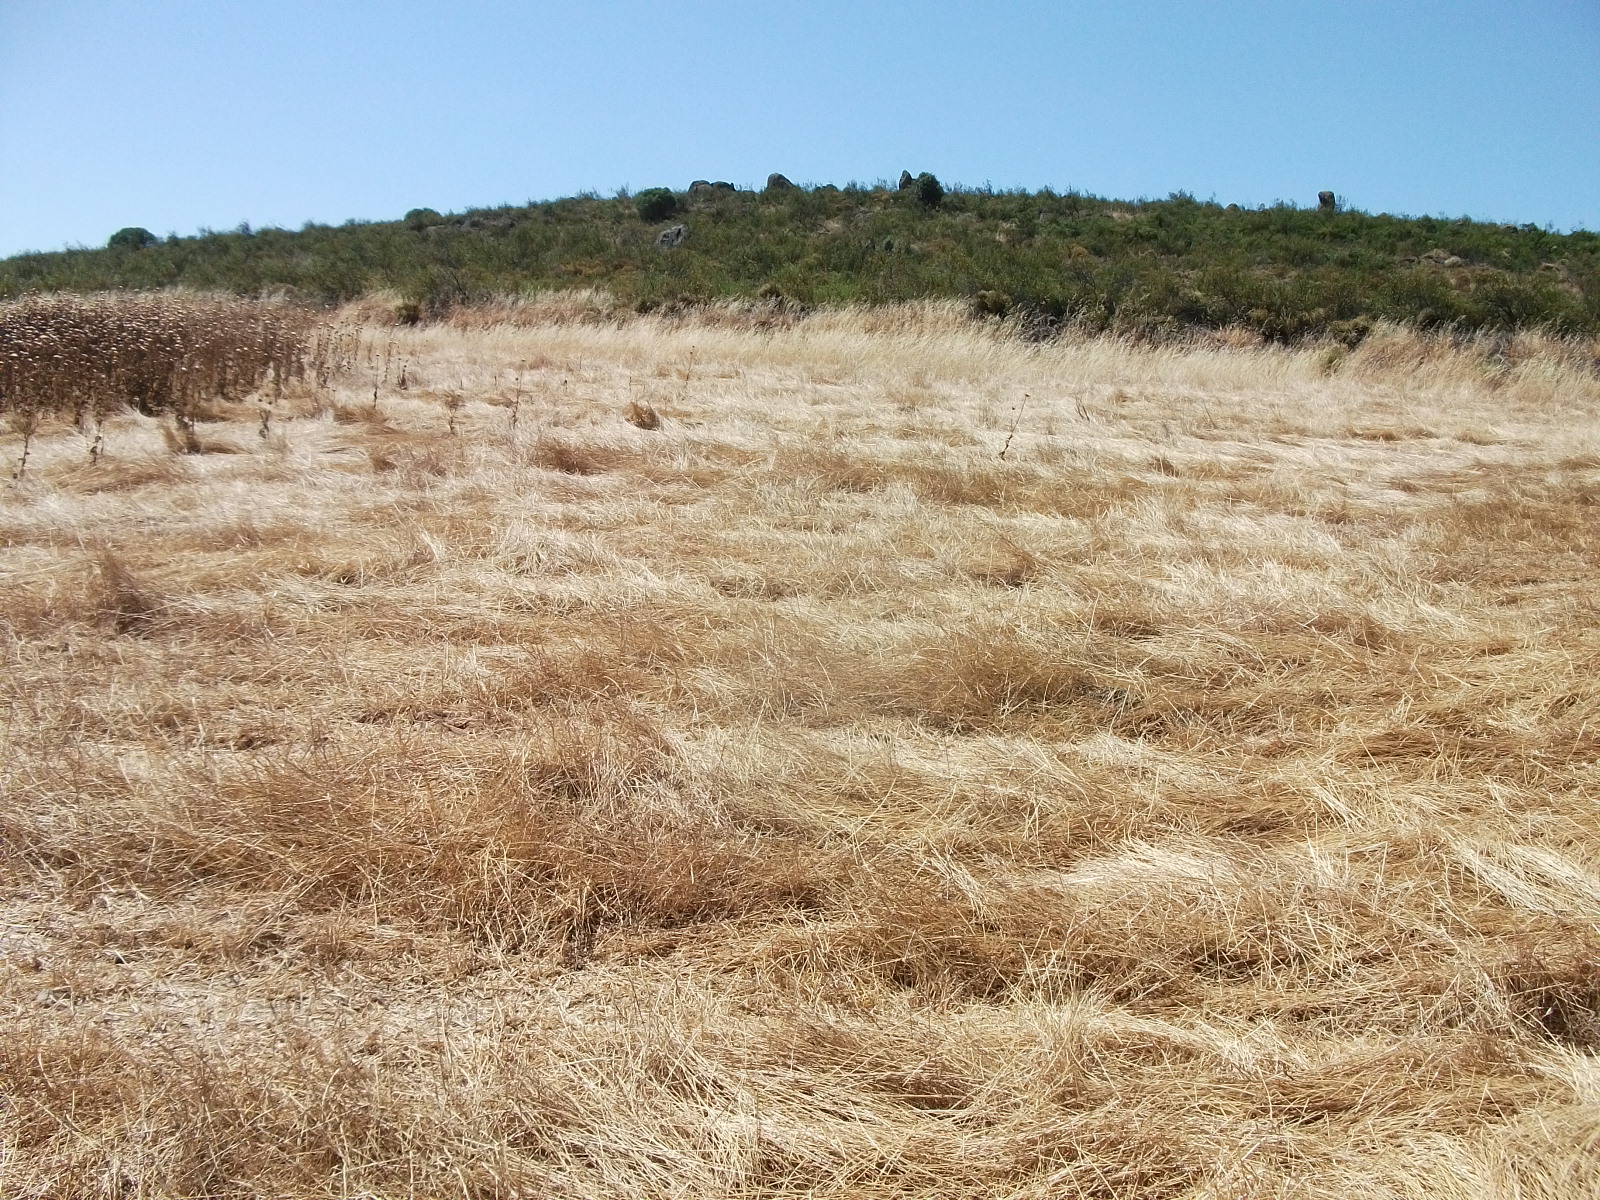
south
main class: Grassland
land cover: Grassland without tree/shrub cover
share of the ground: > 75 %
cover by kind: herbaceous plants 100 %
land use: Agriculture (excluding fallow land and kitchen gardens)
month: June
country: ES
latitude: 37.6095
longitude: -7.0971
